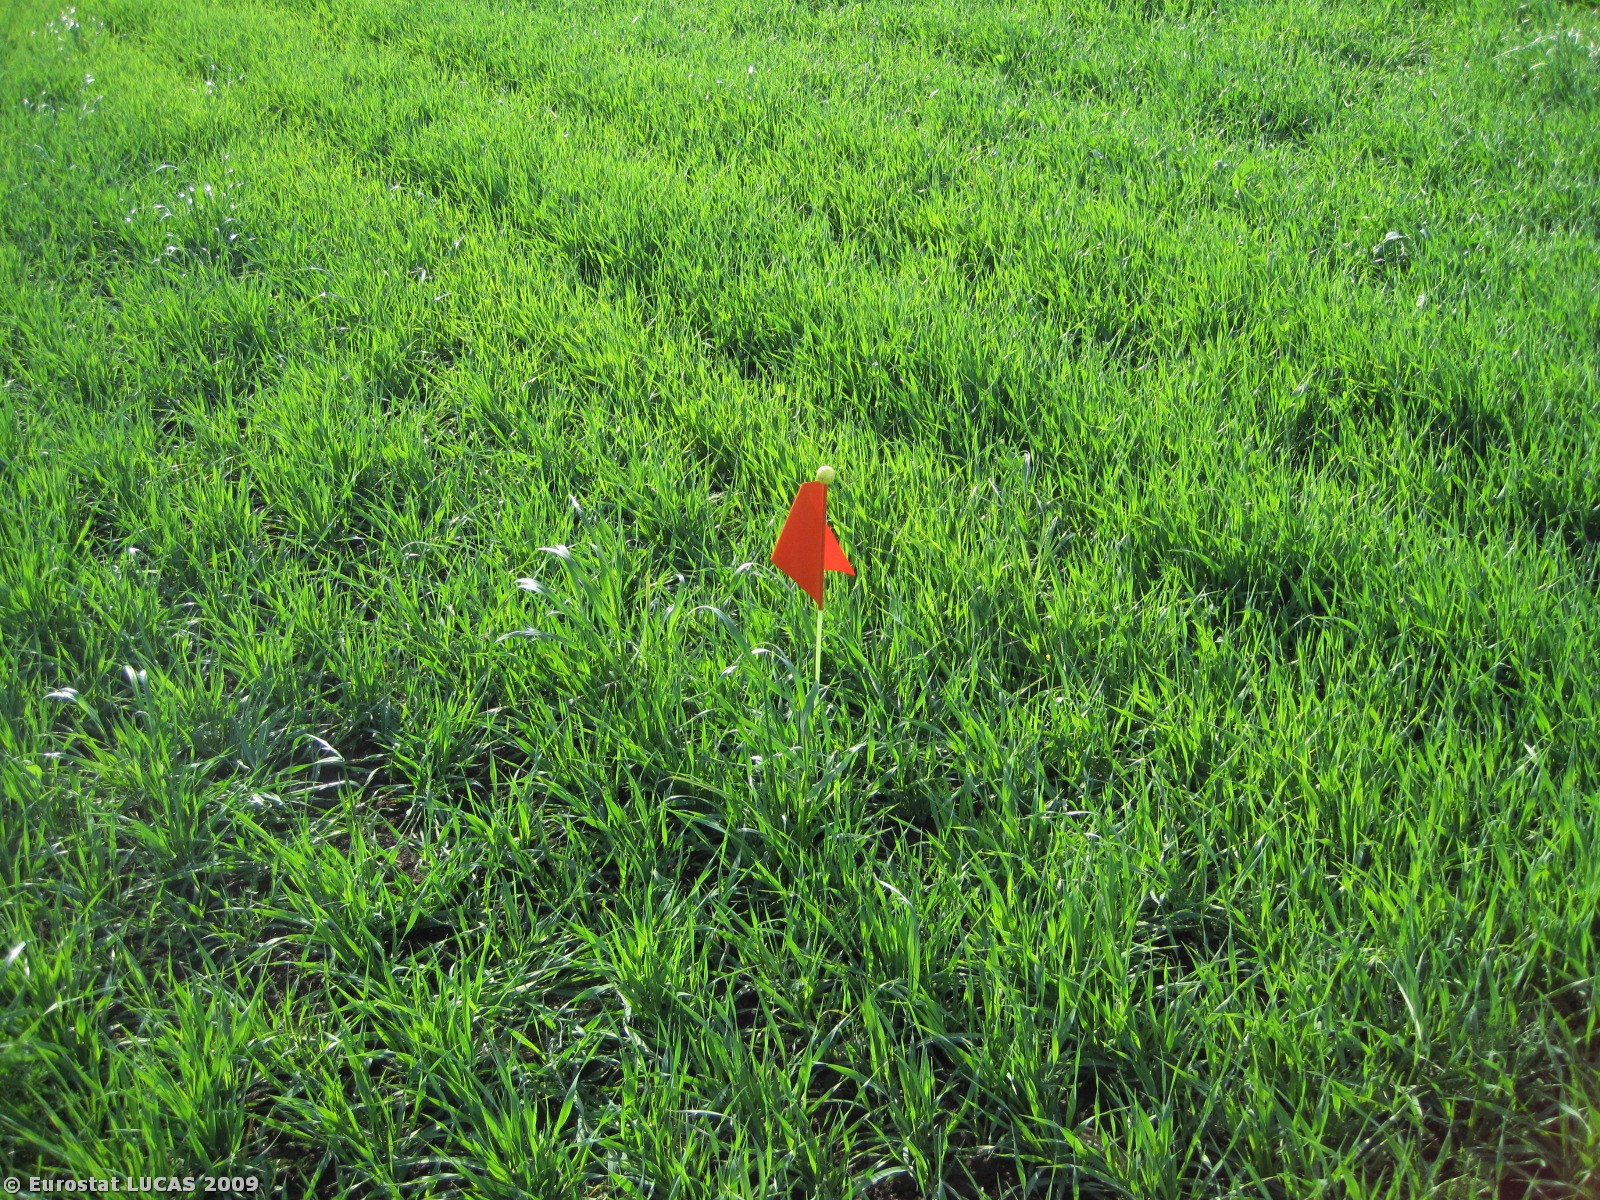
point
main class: Cropland
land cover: Barley
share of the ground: > 75 %
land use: Agriculture (excluding fallow land and kitchen gardens)
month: May
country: DK
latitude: 56.8888
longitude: 9.9836
